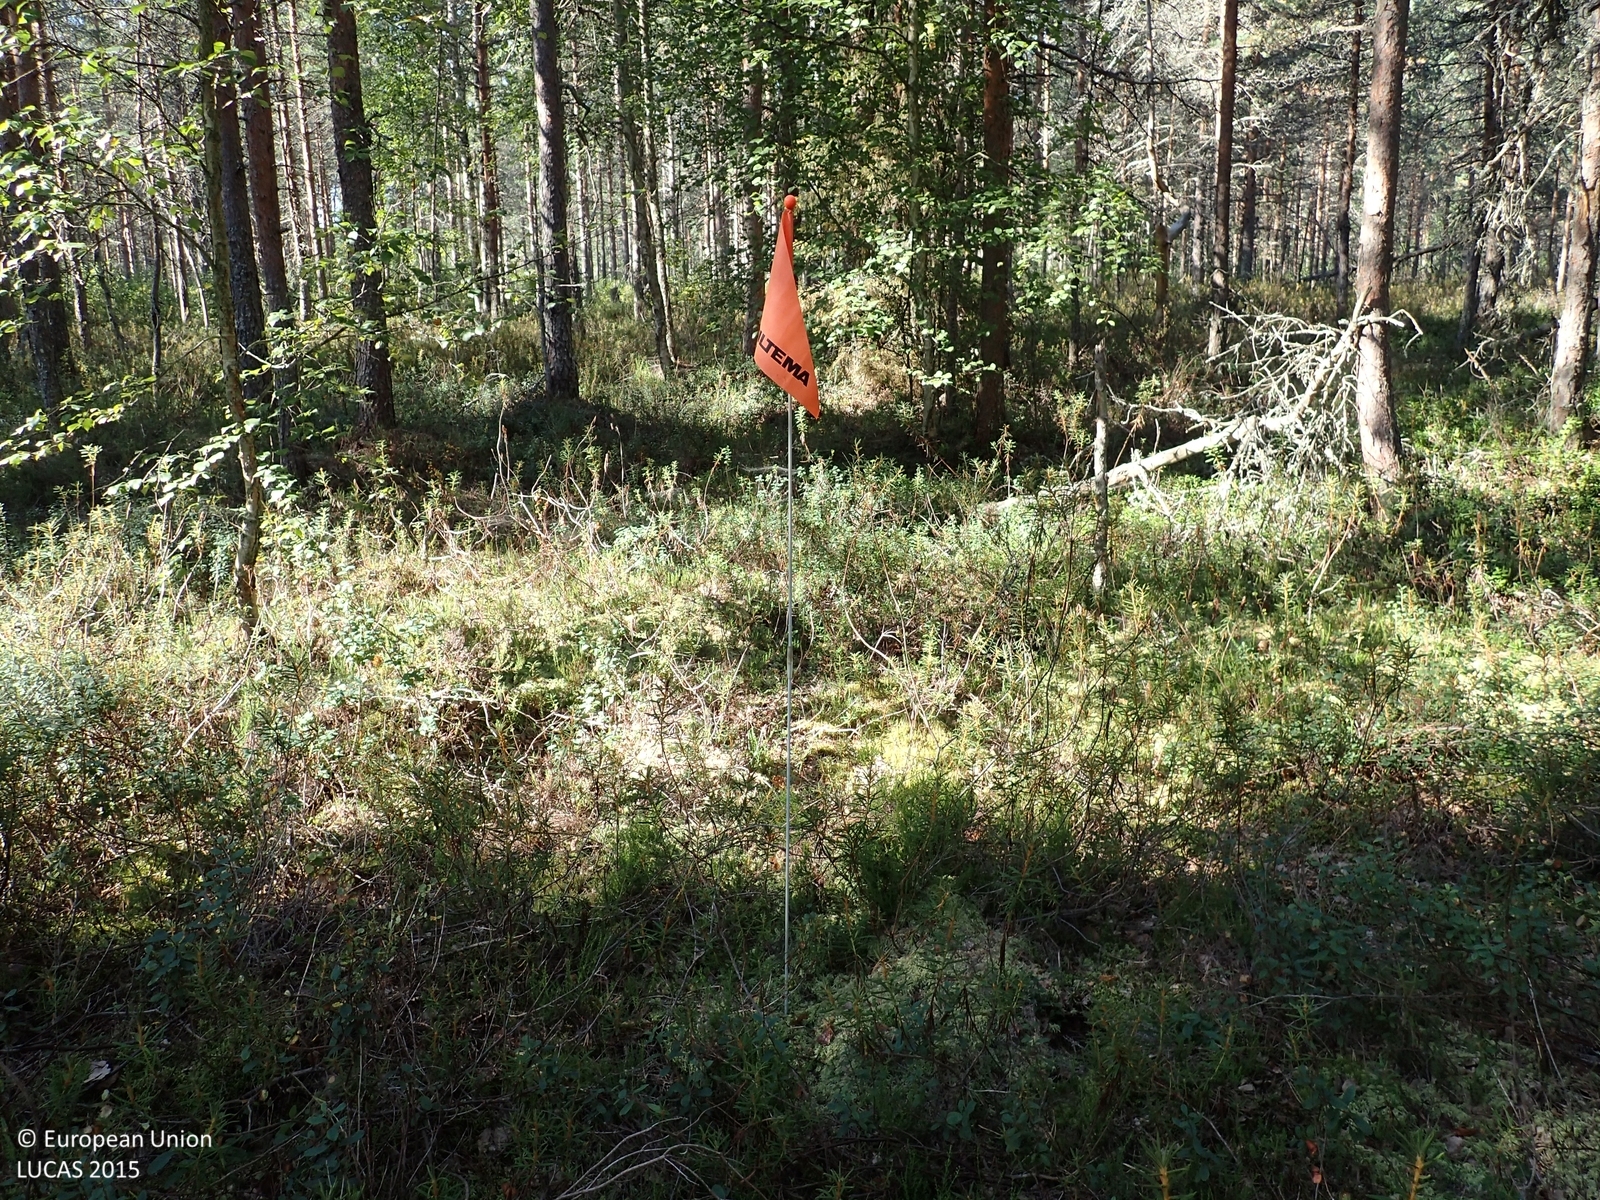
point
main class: Woodland
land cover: Pine dominated coniferous woodland
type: boreal forest
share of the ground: 50 - 75 %
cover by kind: coniferous forest trees 60 %, shrubs 30 %, broadleaved forest trees 5 %, lichens and mosses 5 %
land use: Forestry
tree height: > 5 m
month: August
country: FI
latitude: 62.4263
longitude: 21.9586
